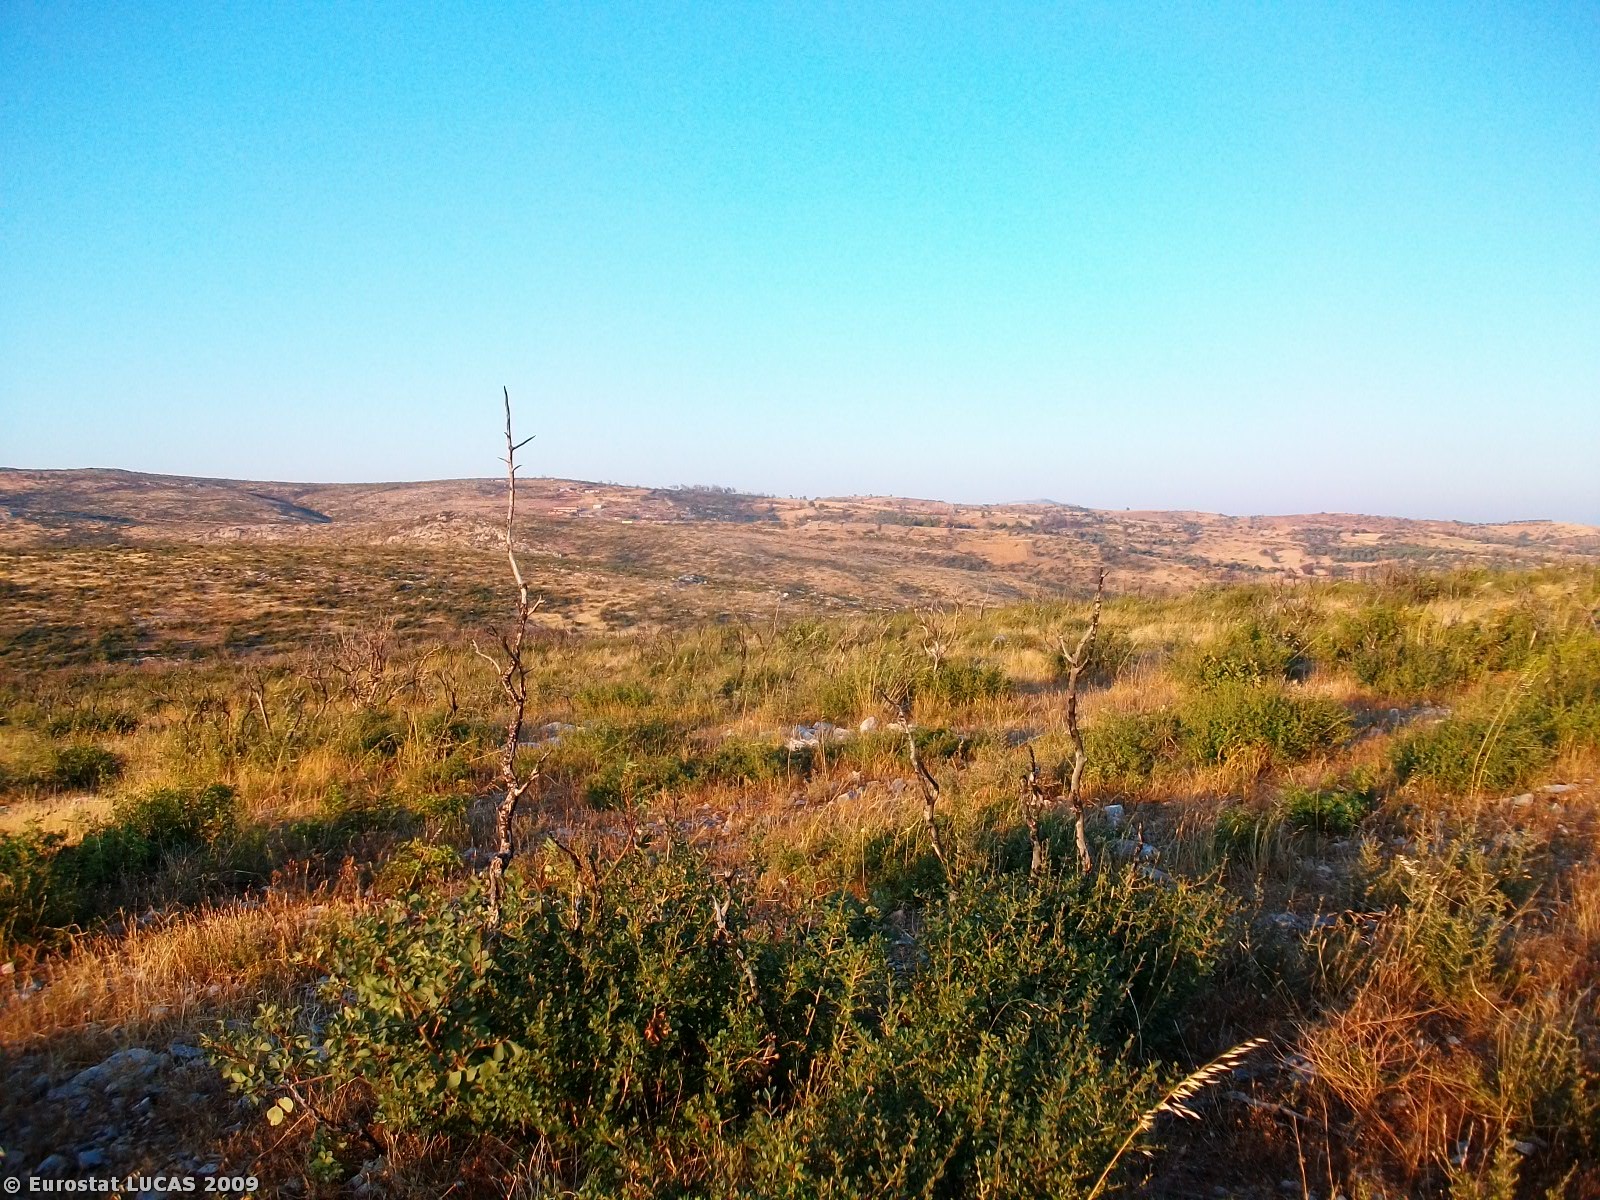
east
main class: Shrubland
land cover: Shrubland without tree cover
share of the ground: 50 - 75 %
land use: Unused
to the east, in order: Shrubland without tree cover
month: August
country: GR
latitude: 38.4681
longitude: 24.0081
